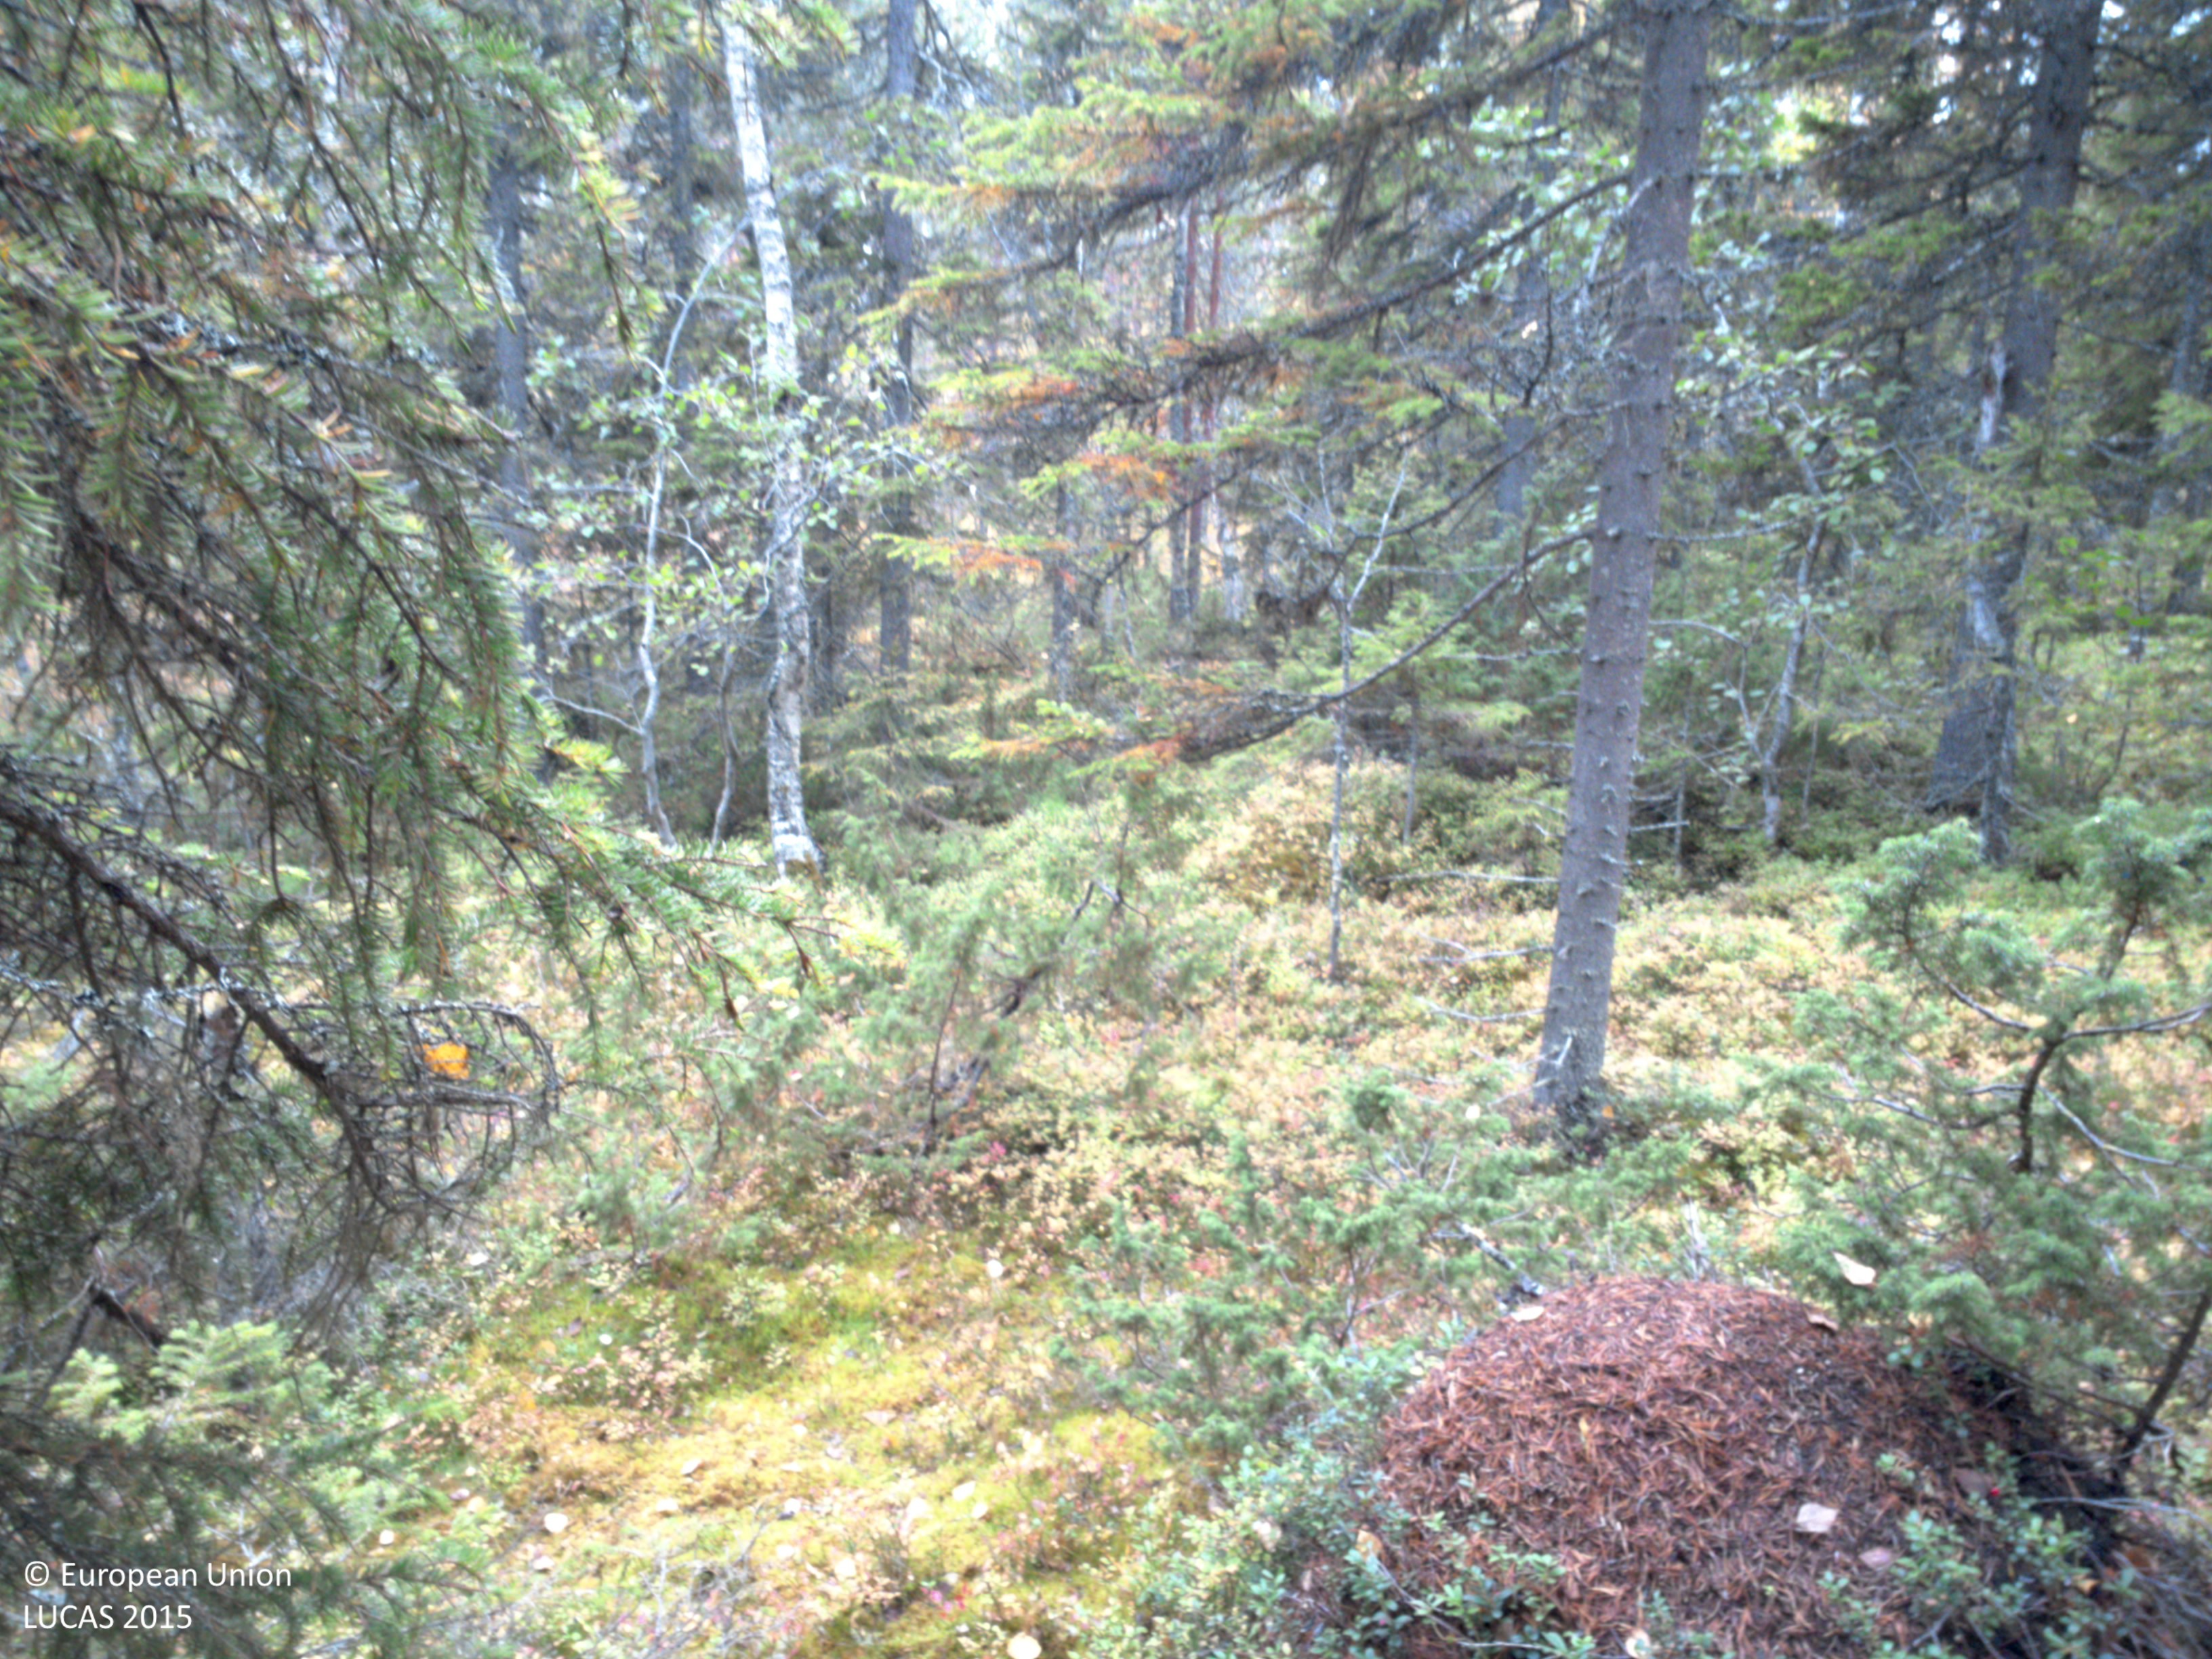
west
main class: Woodland
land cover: Other coniferous woodland
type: boreal forest
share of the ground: > 75 %
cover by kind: coniferous forest trees 75 %, broadleaved forest trees 10 %, shrubs 5 %, herbaceous plants 5 %, lichens and mosses 5 %
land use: Forestry
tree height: > 5 m
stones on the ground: < 10 %
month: September
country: SE
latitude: 64.8761
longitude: 18.8953
